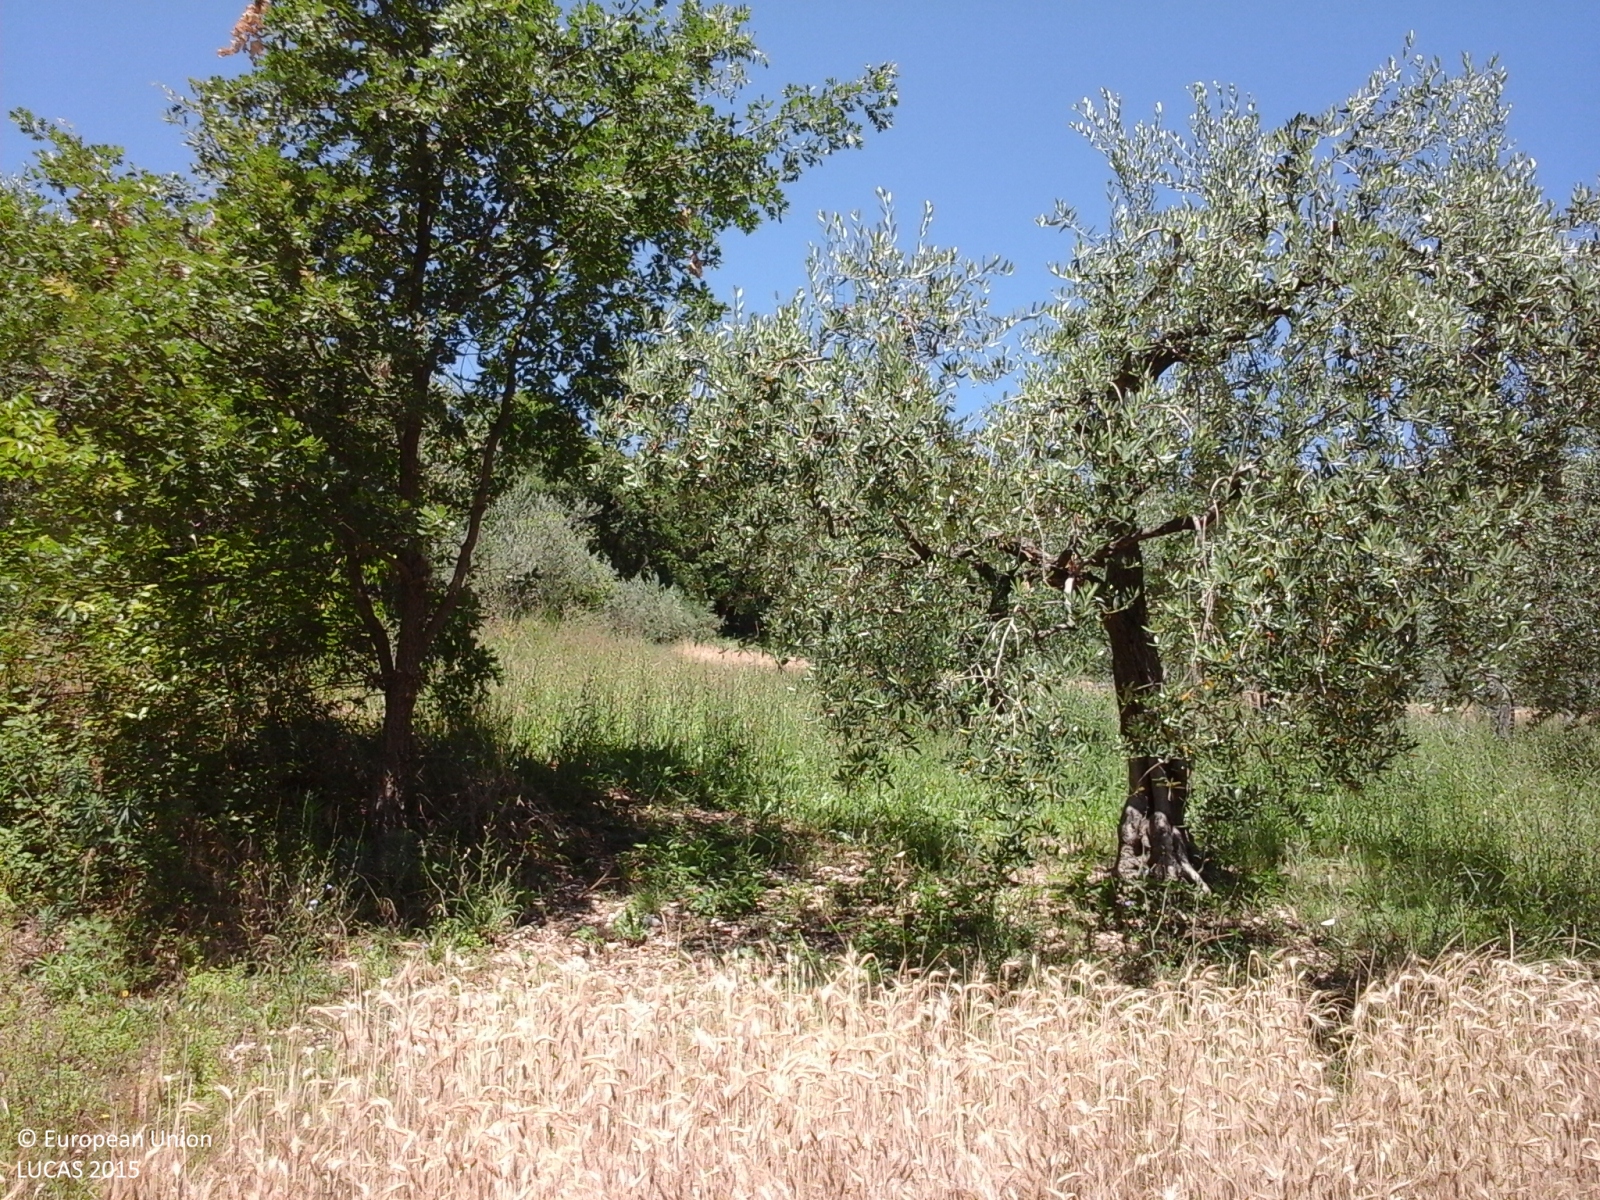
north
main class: Cropland
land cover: Triticale
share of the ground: > 75 %
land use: Agriculture (excluding fallow land and kitchen gardens)
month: June
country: IT
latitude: 42.1495
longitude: 14.2341
